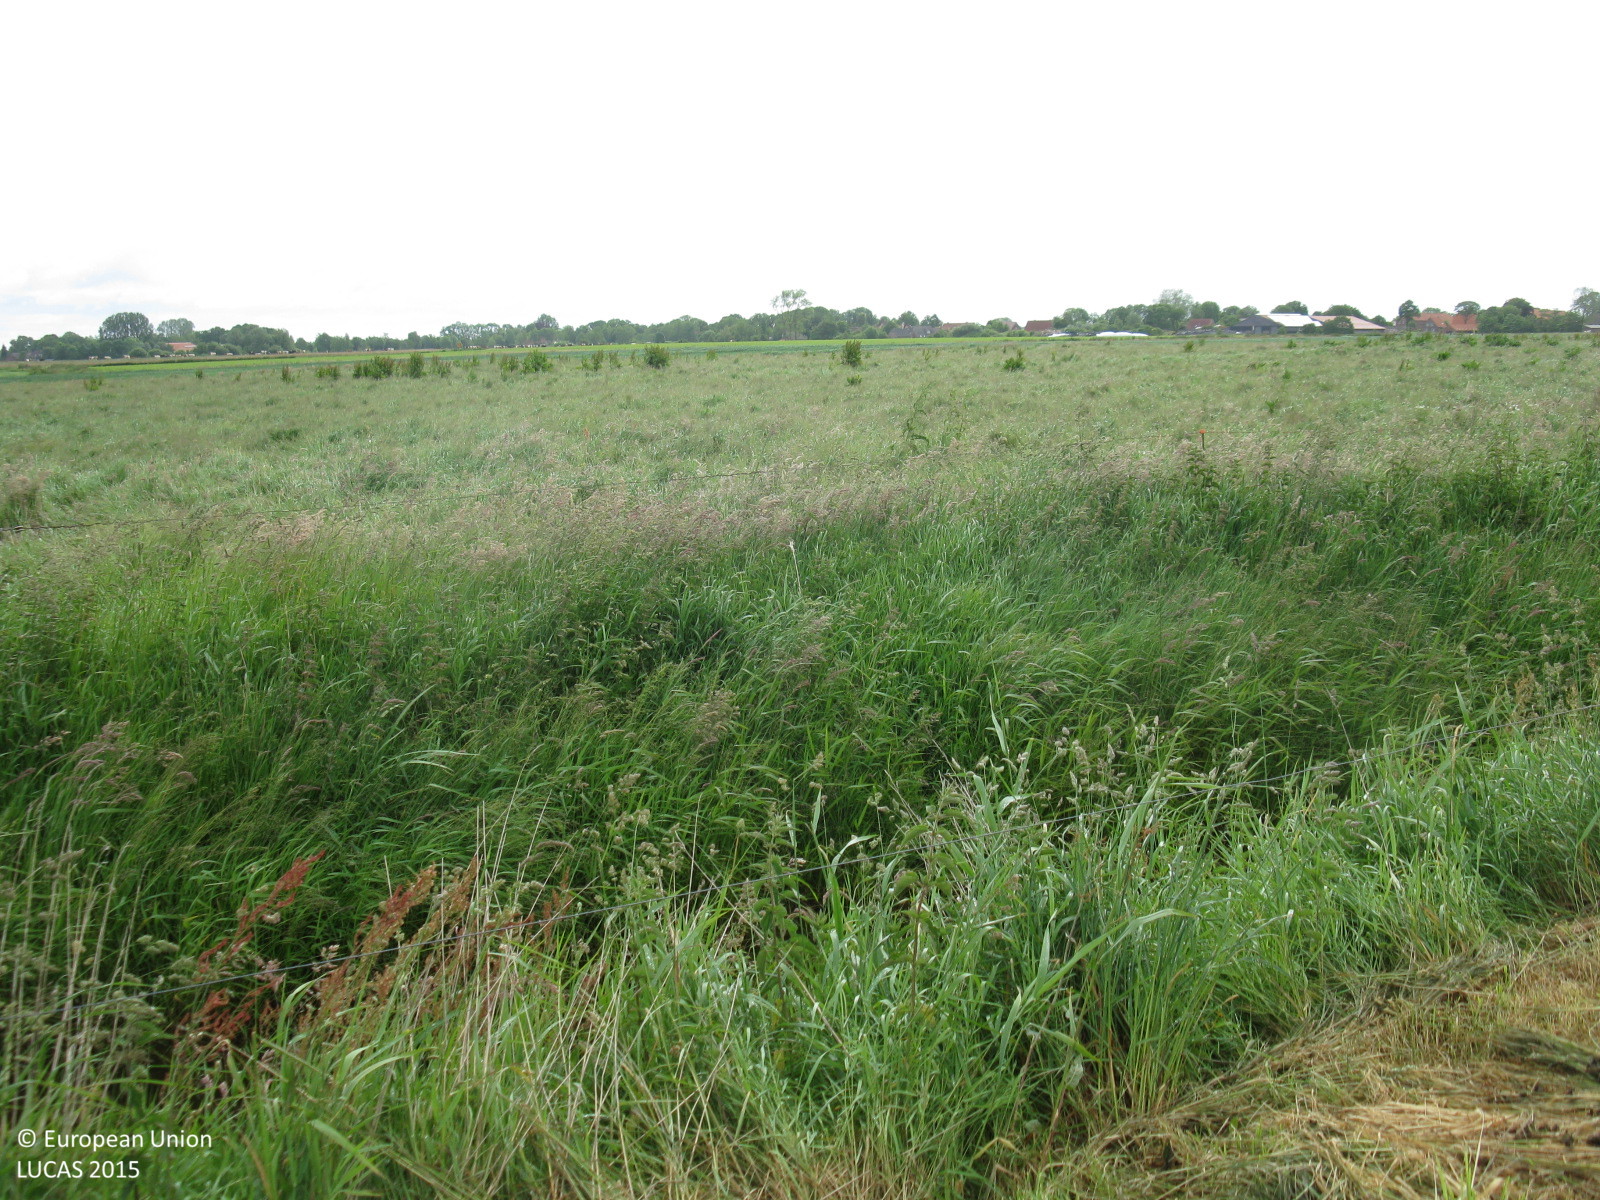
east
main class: Grassland
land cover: Grassland without tree/shrub cover
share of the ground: > 75 %
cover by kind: herbaceous plants 100 %
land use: Agriculture (excluding fallow land and kitchen gardens)
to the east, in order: Grassland without tree/shrub cover; Fences; Grass margins; Ditches and canals; Grass margins; Fences; Grassland without tree/shrub cover; Fences; Oats; Tracks; Grass margins; Ditches and canals; Shruby margins; Maize
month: June
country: DE
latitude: 53.4626
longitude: 7.3346
